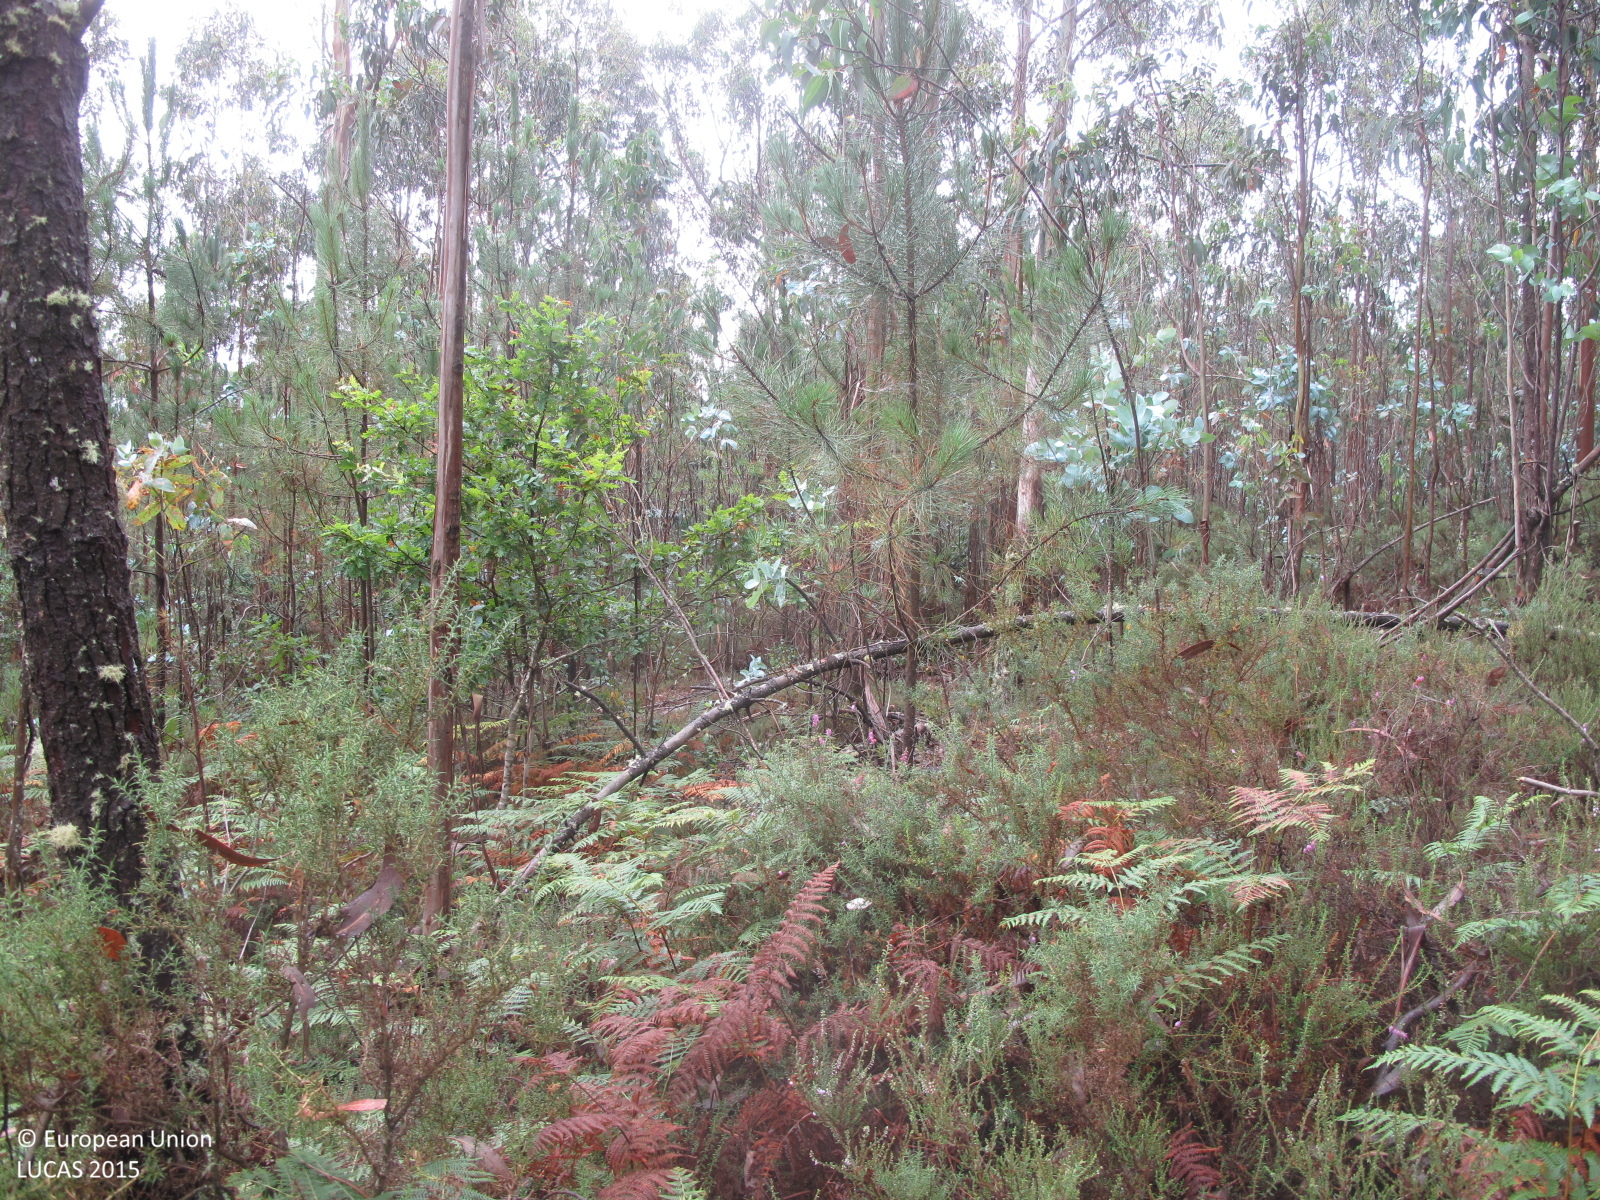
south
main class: Woodland
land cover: Pine dominated mixed woodland
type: hemiboreal forest and nemoral coniferous forest and mixed broadleaved-coniferous forest
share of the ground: 50 - 75 %
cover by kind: coniferous forest trees 40 %, broadleaved forest trees 30 %, shrubs 20 %, herbaceous plants 10 %
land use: Forestry
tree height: > 5 m
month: July
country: ES
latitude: 43.0646
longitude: -9.1481
